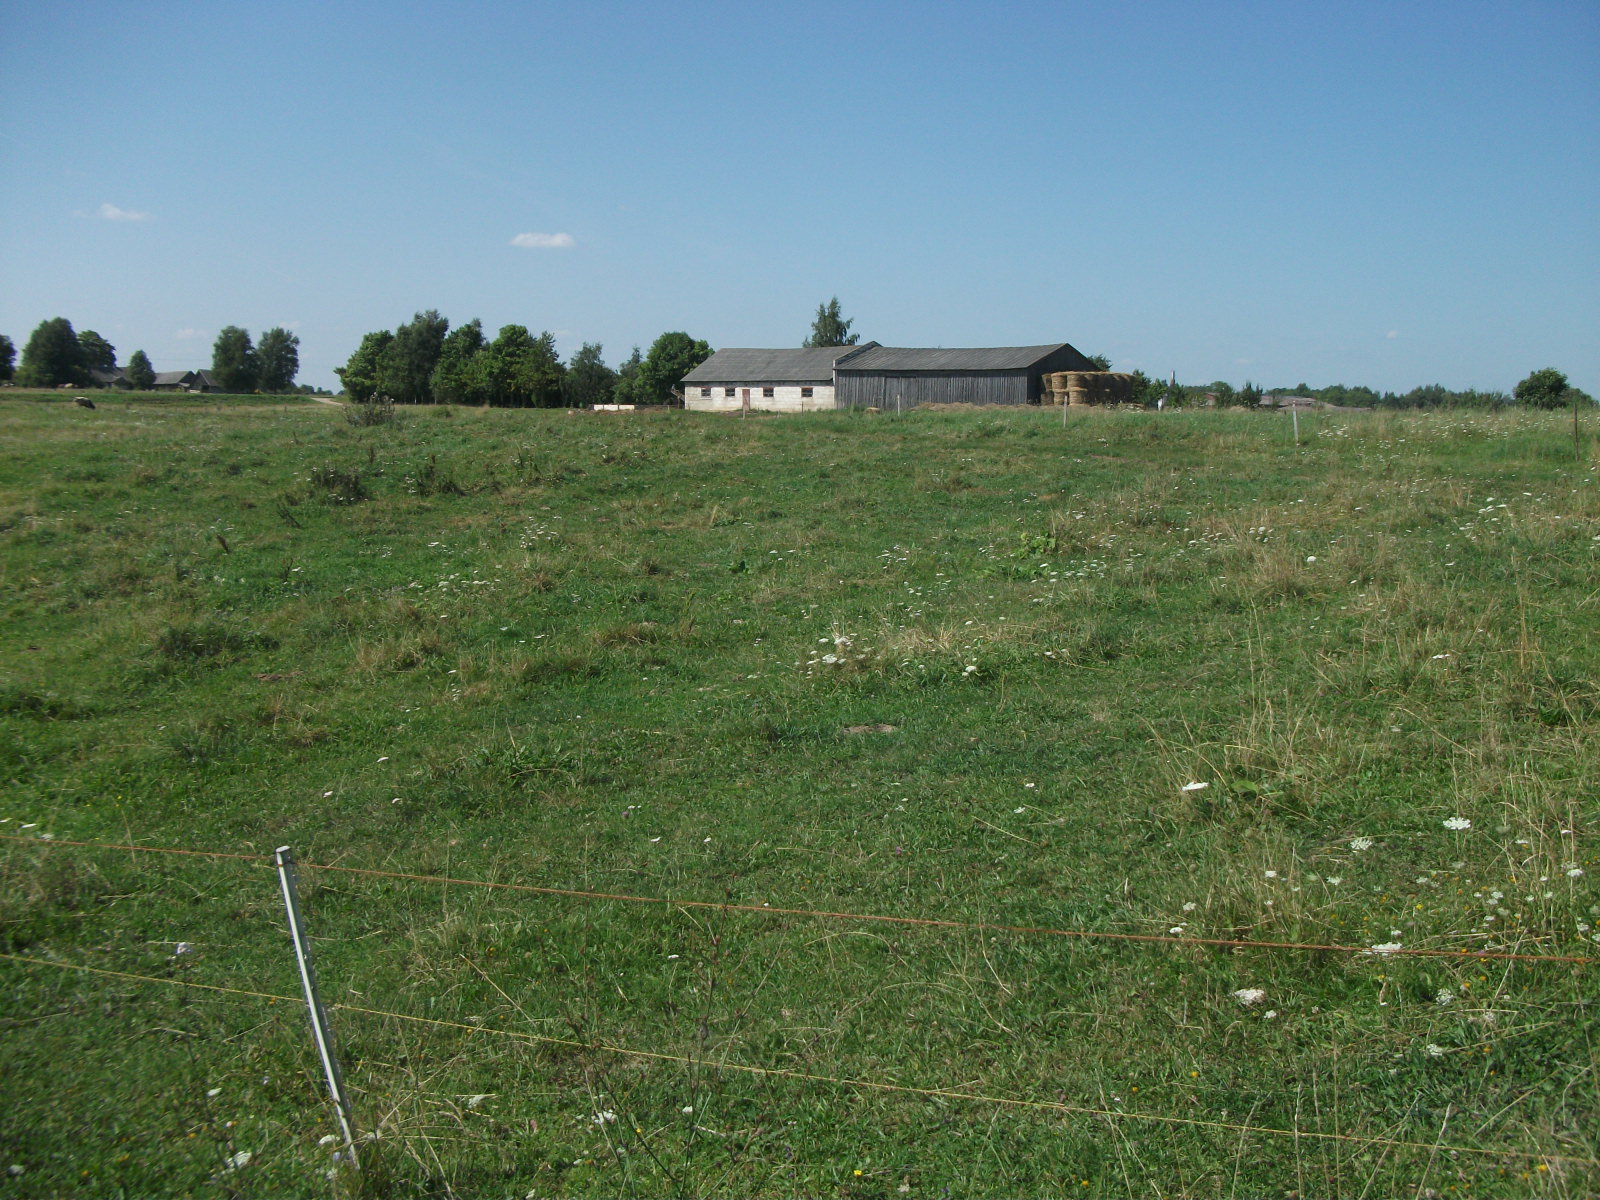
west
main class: Grassland
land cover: Grassland without tree/shrub cover
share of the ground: > 75 %
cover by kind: herbaceous plants 95 %, unconsolidated bare surface 5 %
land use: Agriculture (excluding fallow land and kitchen gardens)
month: August
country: LV
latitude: 56.6626
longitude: 26.5789
